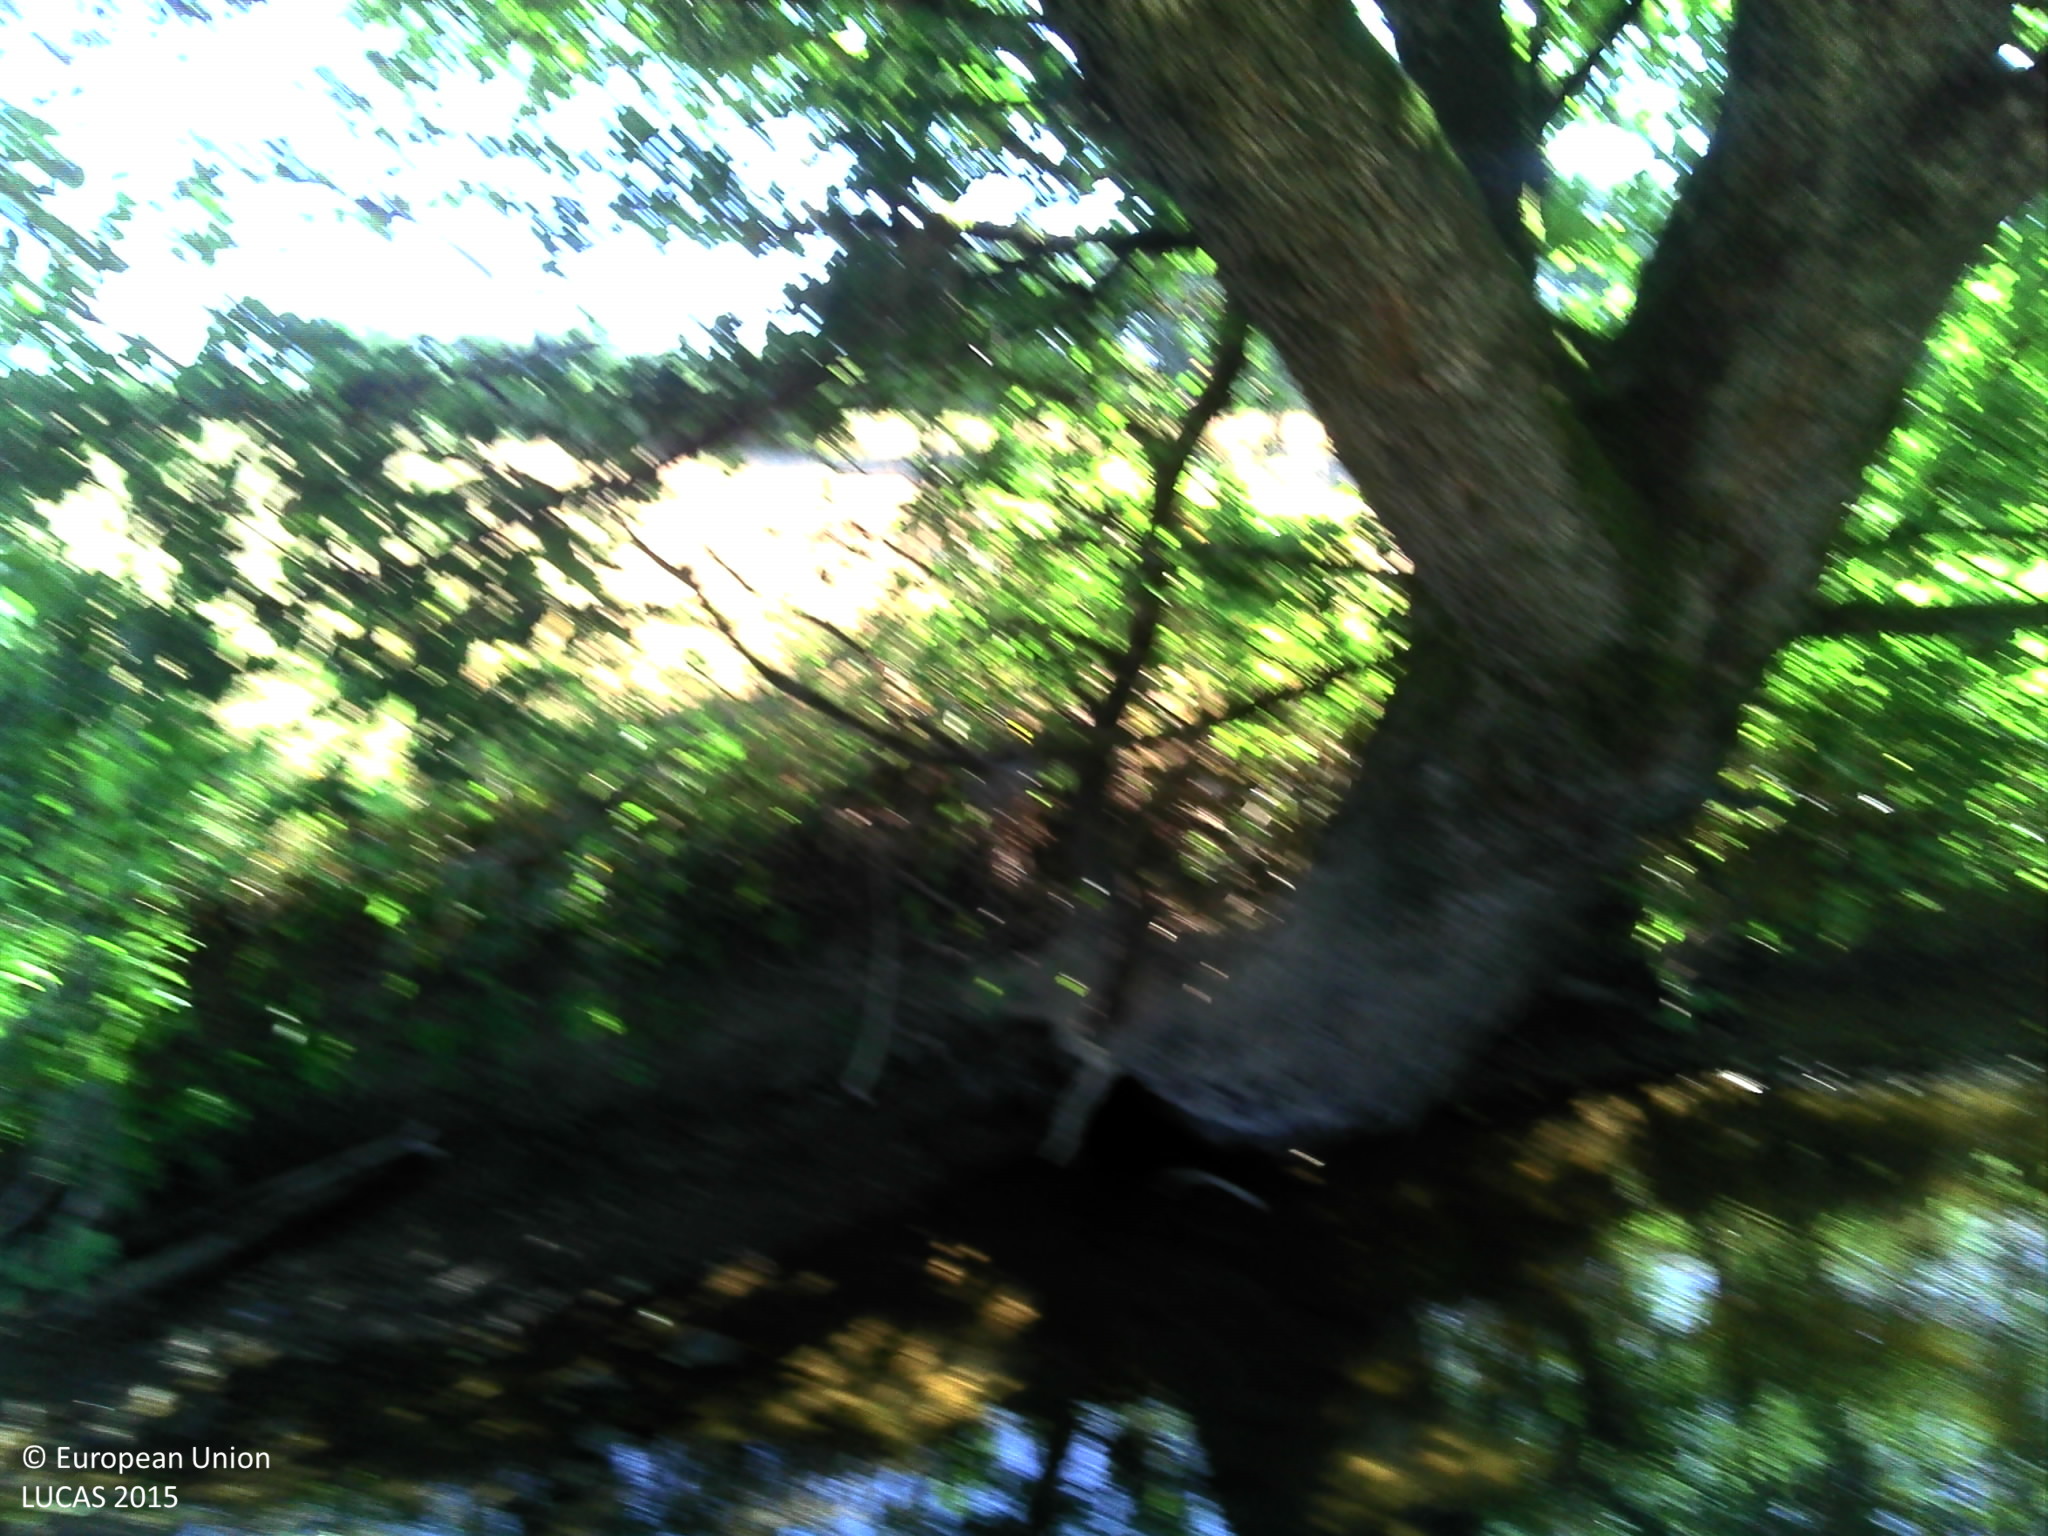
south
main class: Grassland
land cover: Grassland without tree/shrub cover
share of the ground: > 75 %
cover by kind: herbaceous plants 100 %
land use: Agriculture (excluding fallow land and kitchen gardens)
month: July
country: FR
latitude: 46.9900
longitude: 3.5944
